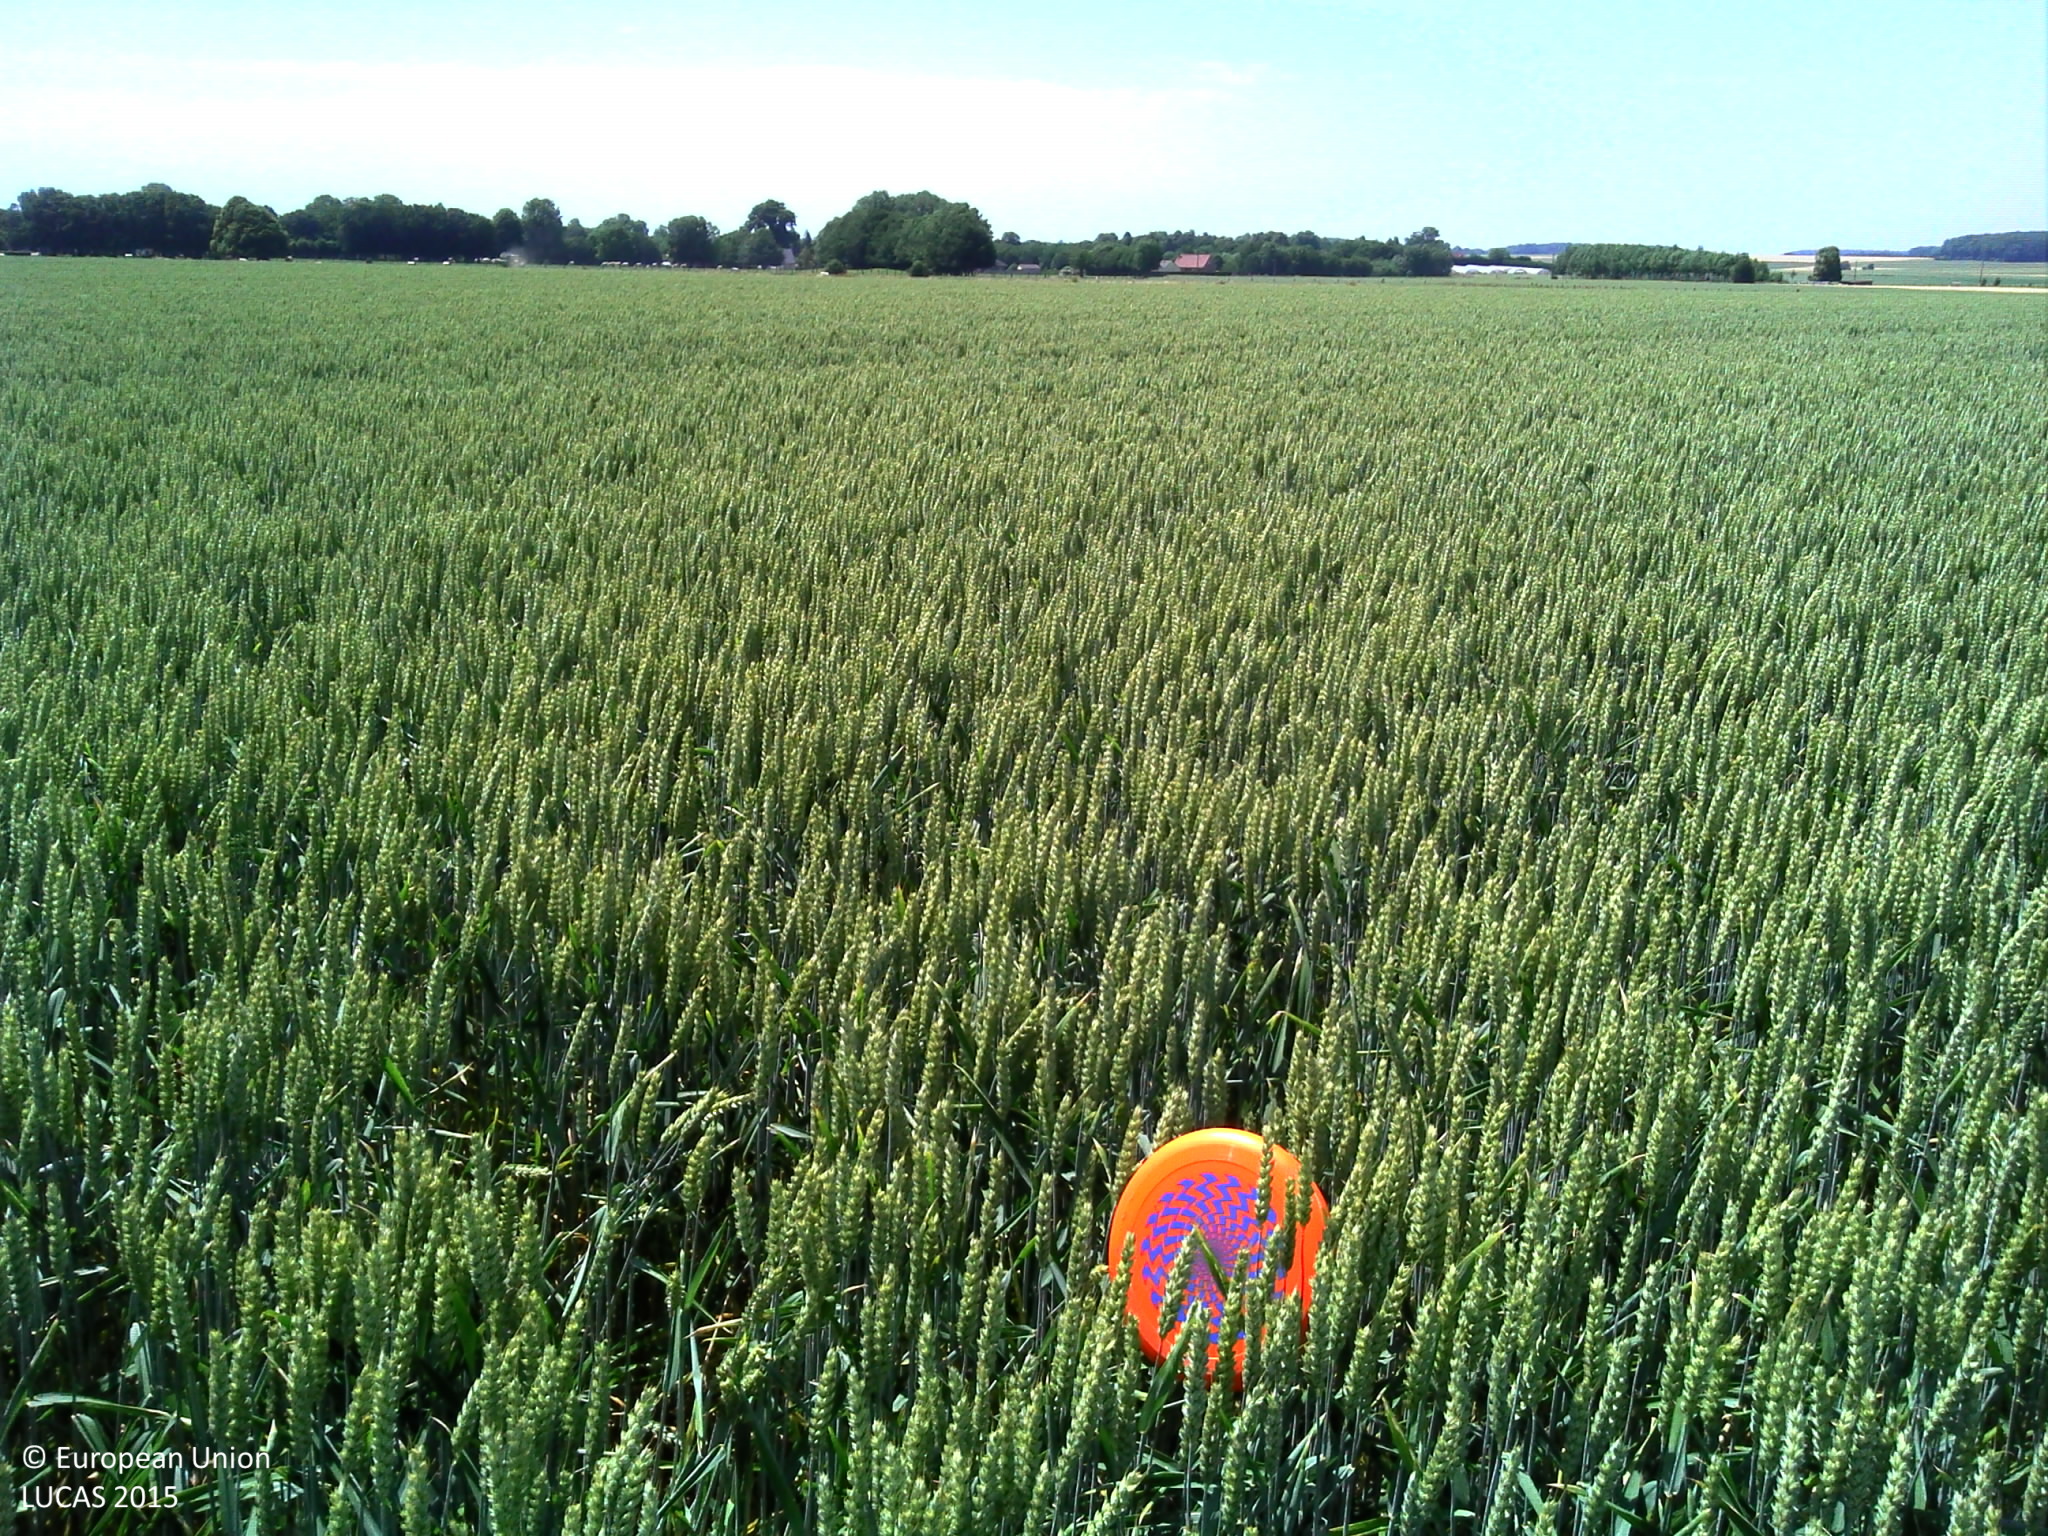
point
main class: Cropland
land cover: Common wheat
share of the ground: > 75 %
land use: Agriculture (excluding fallow land and kitchen gardens)
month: July
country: FR
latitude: 50.2610
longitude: 2.4827
